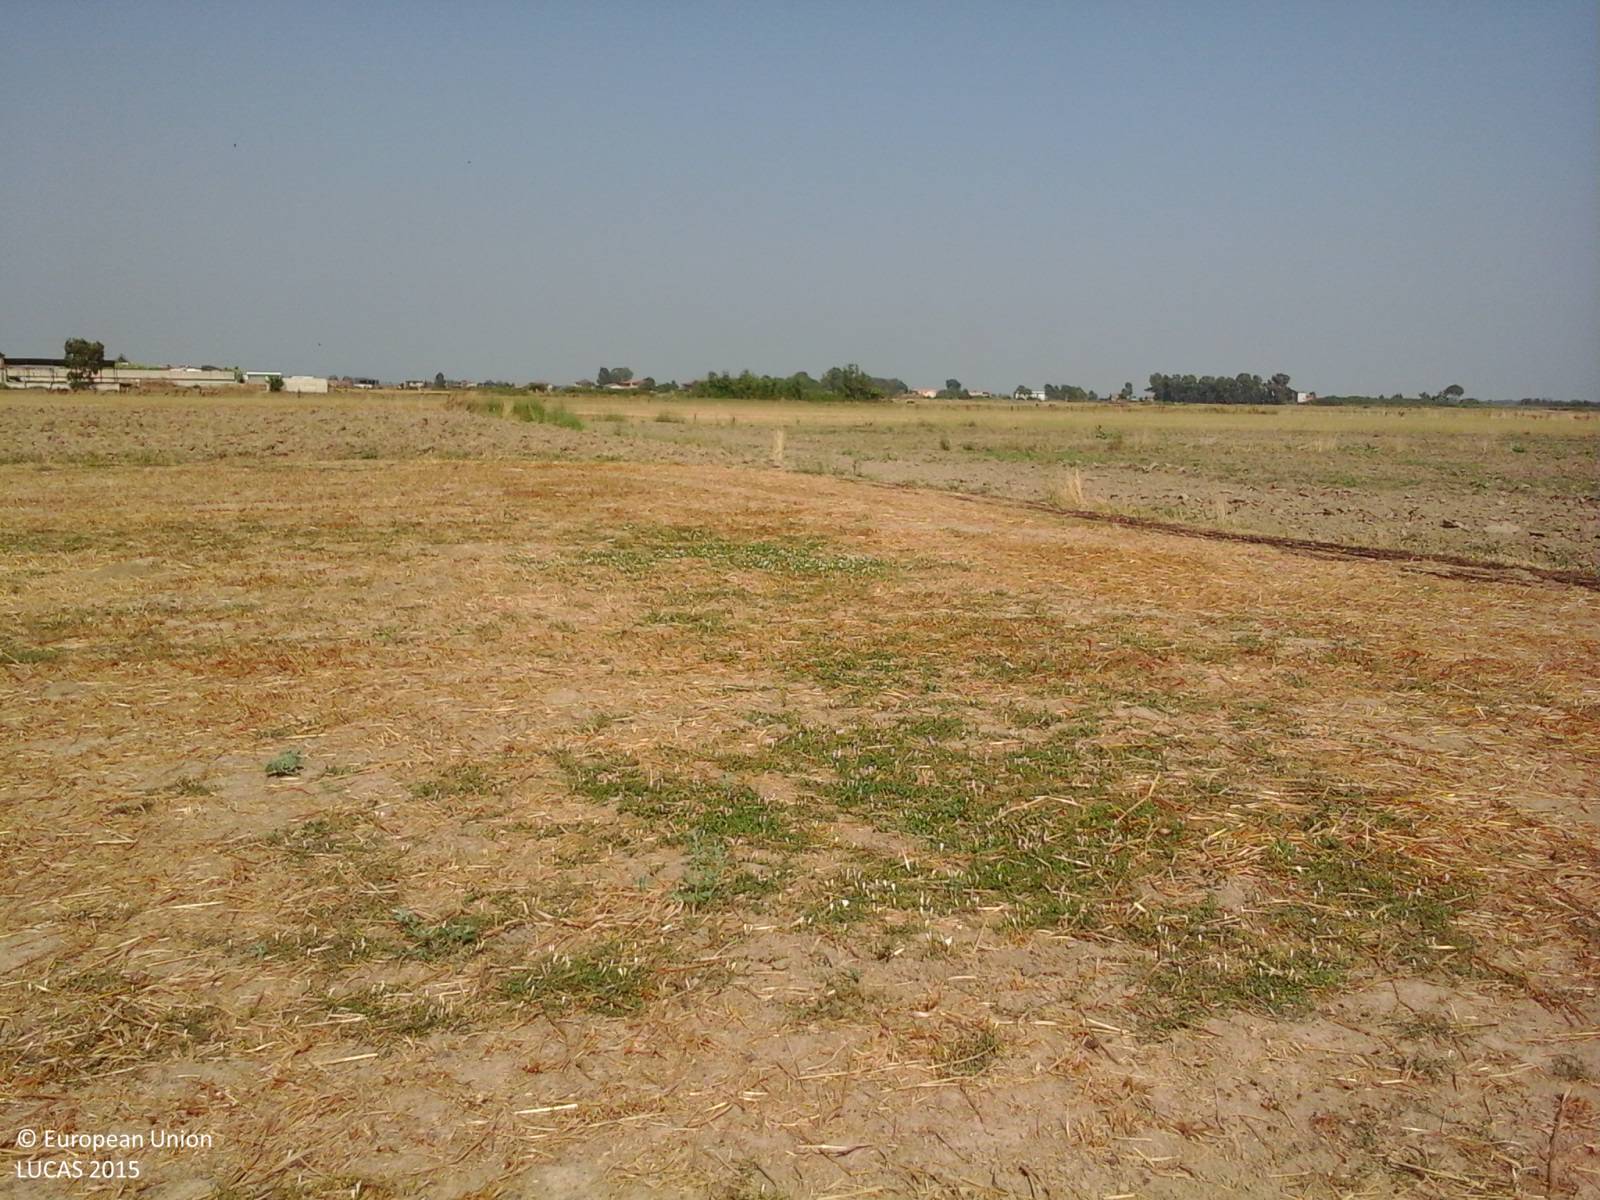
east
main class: Cropland
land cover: Temporary grasslands
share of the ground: > 75 %
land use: Agriculture (excluding fallow land and kitchen gardens)
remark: Harvested field
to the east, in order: Temporary grasslands; Grass margins; Other bare soil; Grass margins; Temporary grasslands
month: July
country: IT
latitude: 41.0384
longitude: 13.9687
